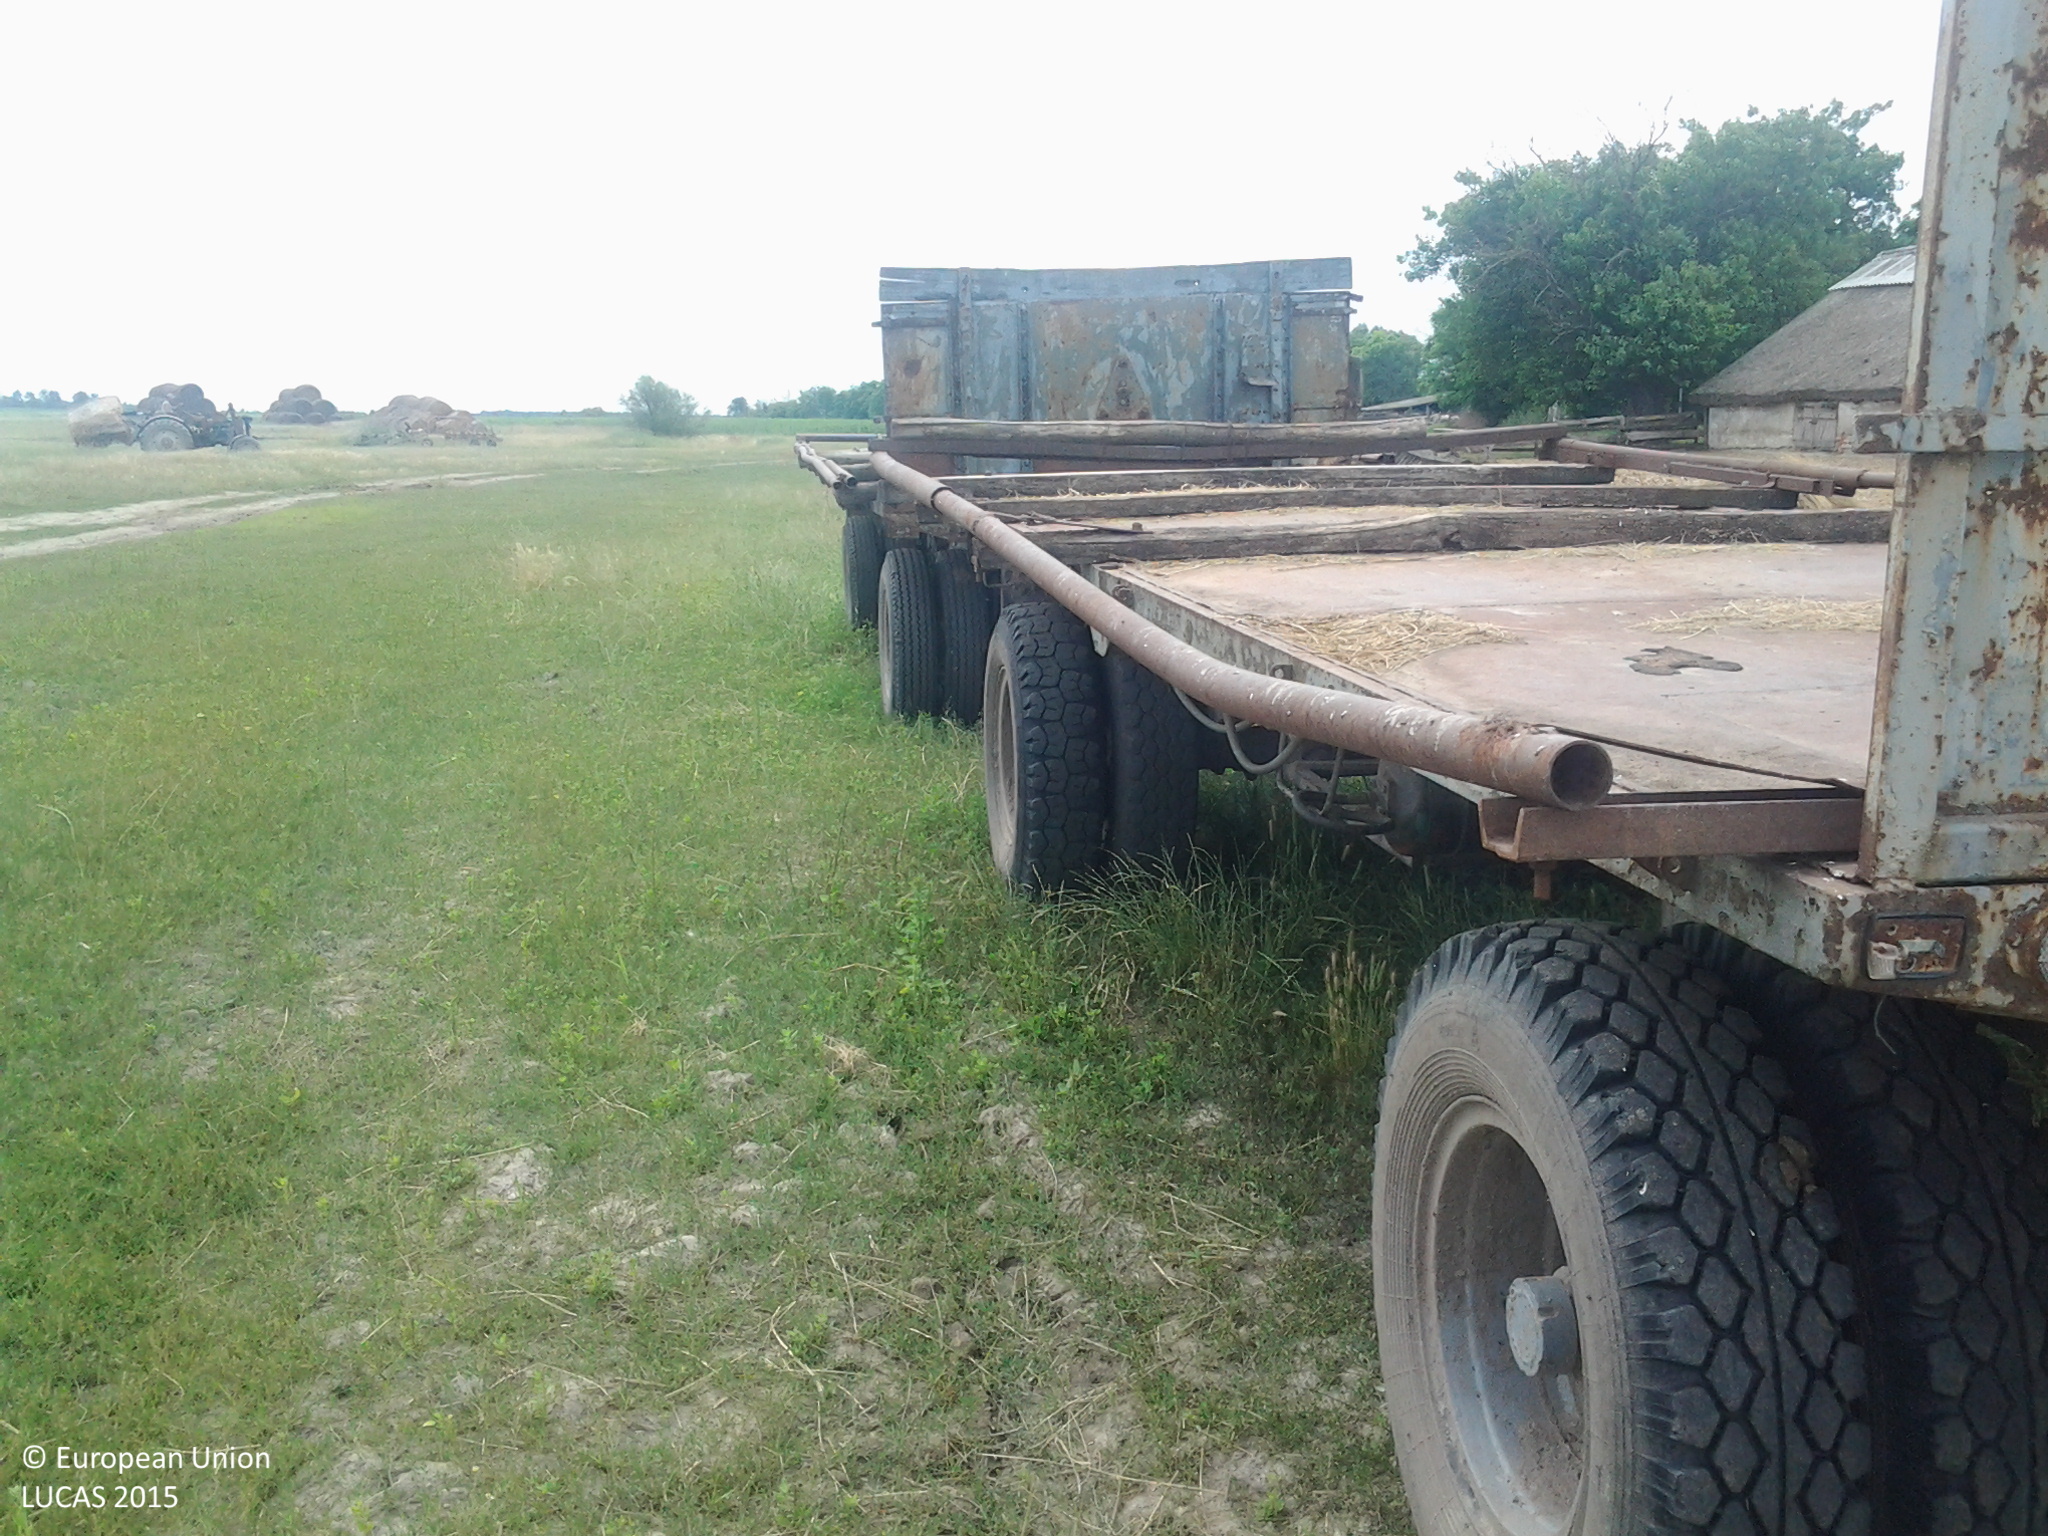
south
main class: Grassland
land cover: Grassland without tree/shrub cover
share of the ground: > 75 %
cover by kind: herbaceous plants 100 %
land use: Agriculture (excluding fallow land and kitchen gardens)
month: June
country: HU
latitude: 46.9929
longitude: 19.1290
